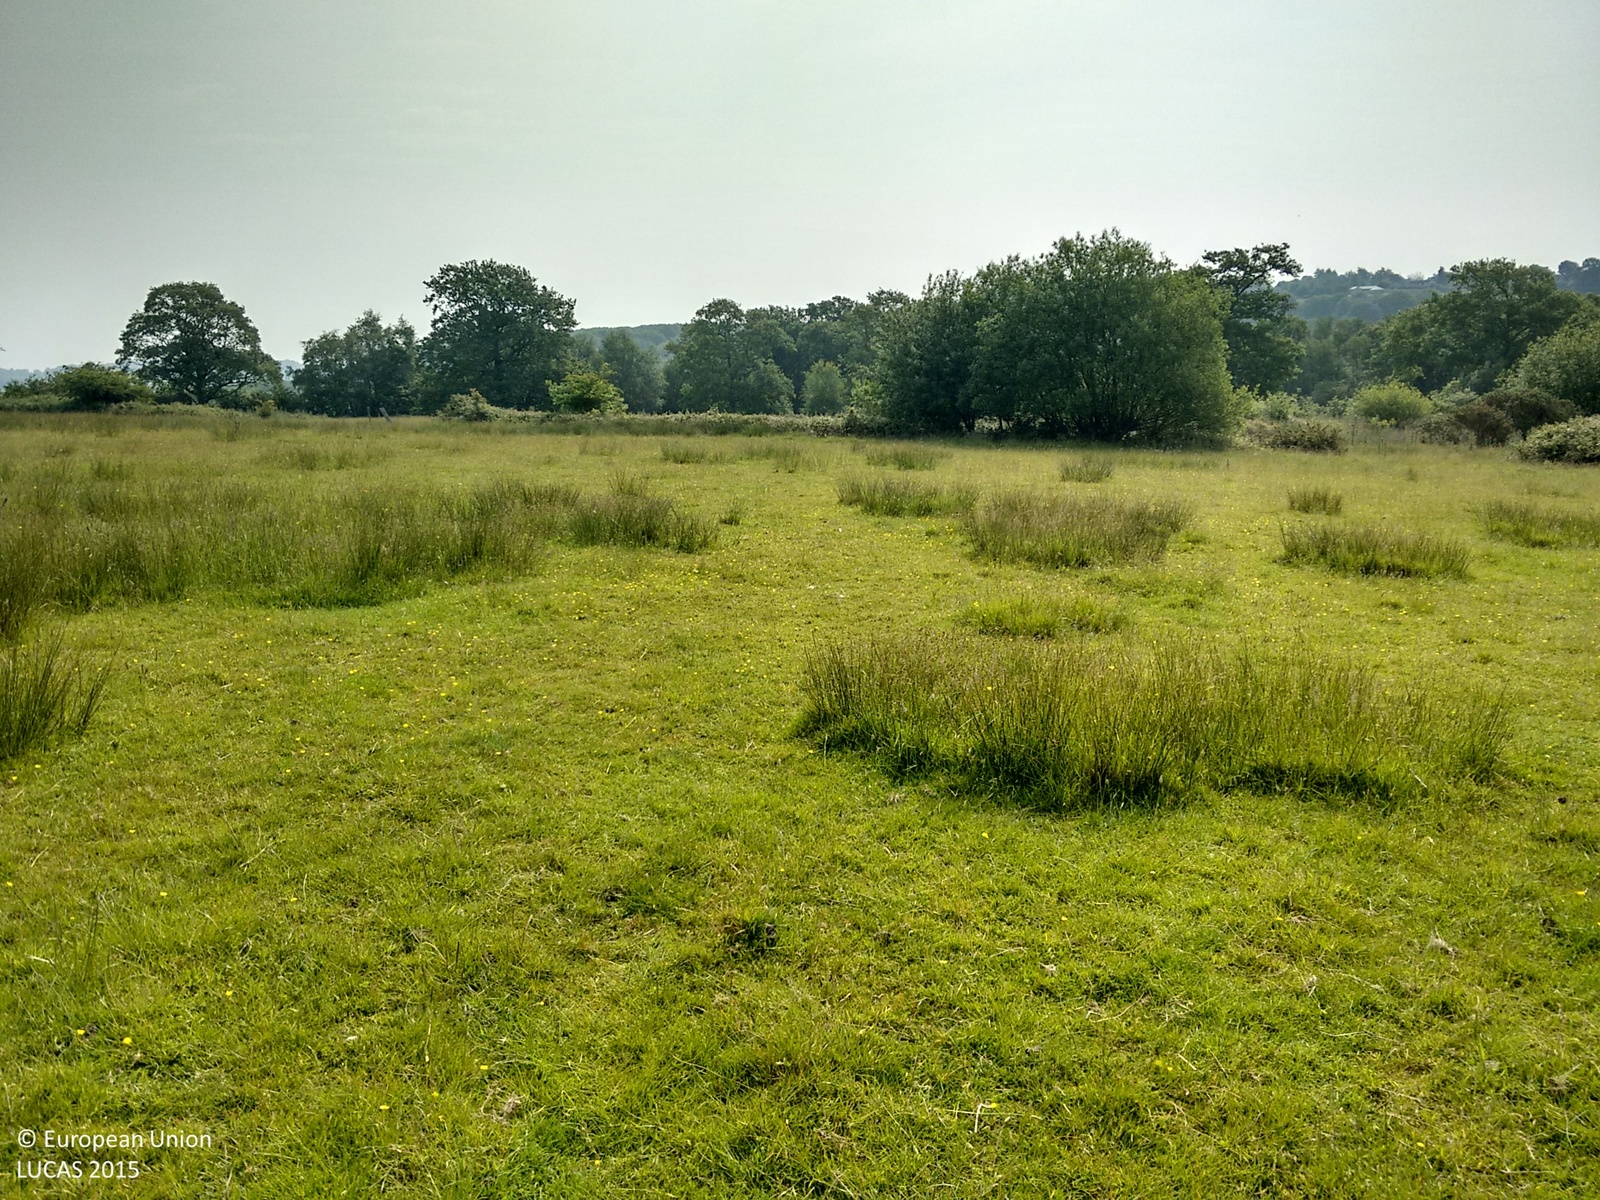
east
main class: Grassland
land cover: Grassland without tree/shrub cover
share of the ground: > 75 %
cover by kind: herbaceous plants 100 %
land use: Agriculture (excluding fallow land and kitchen gardens)
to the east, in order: Grassland without tree/shrub cover; Shrubland with sparse tree cover; Broadleaved woodland; Fences; Broadleaved woodland; Grassland without tree/shrub cover; Broadleaved woodland
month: June
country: GB
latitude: 50.9653
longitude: 0.3020
